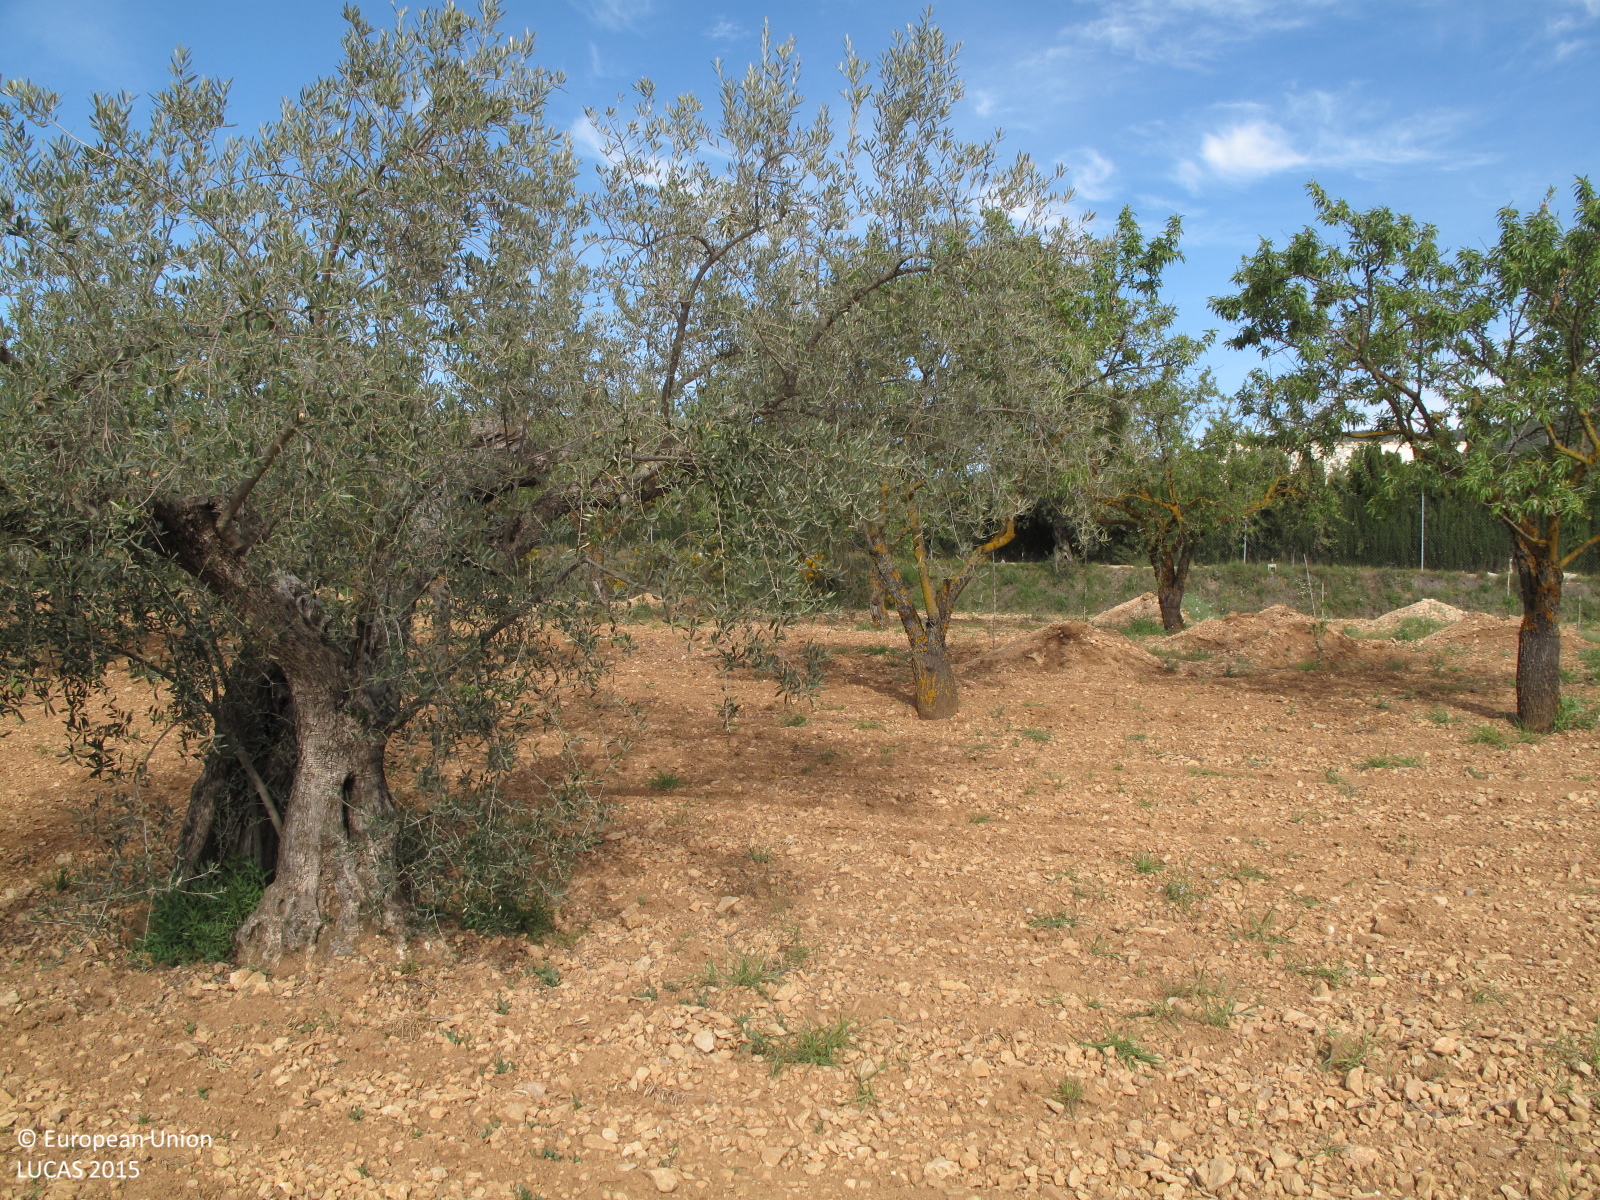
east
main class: Cropland
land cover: Olive groves
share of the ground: 10 - 25 %
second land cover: Other bare soil
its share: > 75 %
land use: Agriculture (excluding fallow land and kitchen gardens)
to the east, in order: Olive groves; Other bare soil; Nuts trees; Grass margins; Lines of trees; Fences; Managed hedges; Artificial constructions in urban areas; Managed hedges; Fences; Grass margins; Olive groves; Grass margins; Olive groves; Tracks; Olive groves; Grass margins; Fences; Grass margins; Nuts trees; Tracks; Grass margins; Tracks; Fences; Grass margins; Tracks; Fences; Spontaneously vegetated surfaces; Lines of trees; Tracks; Lines of trees; Other bare soil; Lines of trees; Grass margins; Fences; Olive groves; Grass margins; Olive groves; Tracks; Olive groves; Shruby margins; Olive groves
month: April
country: ES
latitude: 38.6211
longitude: -0.5441
